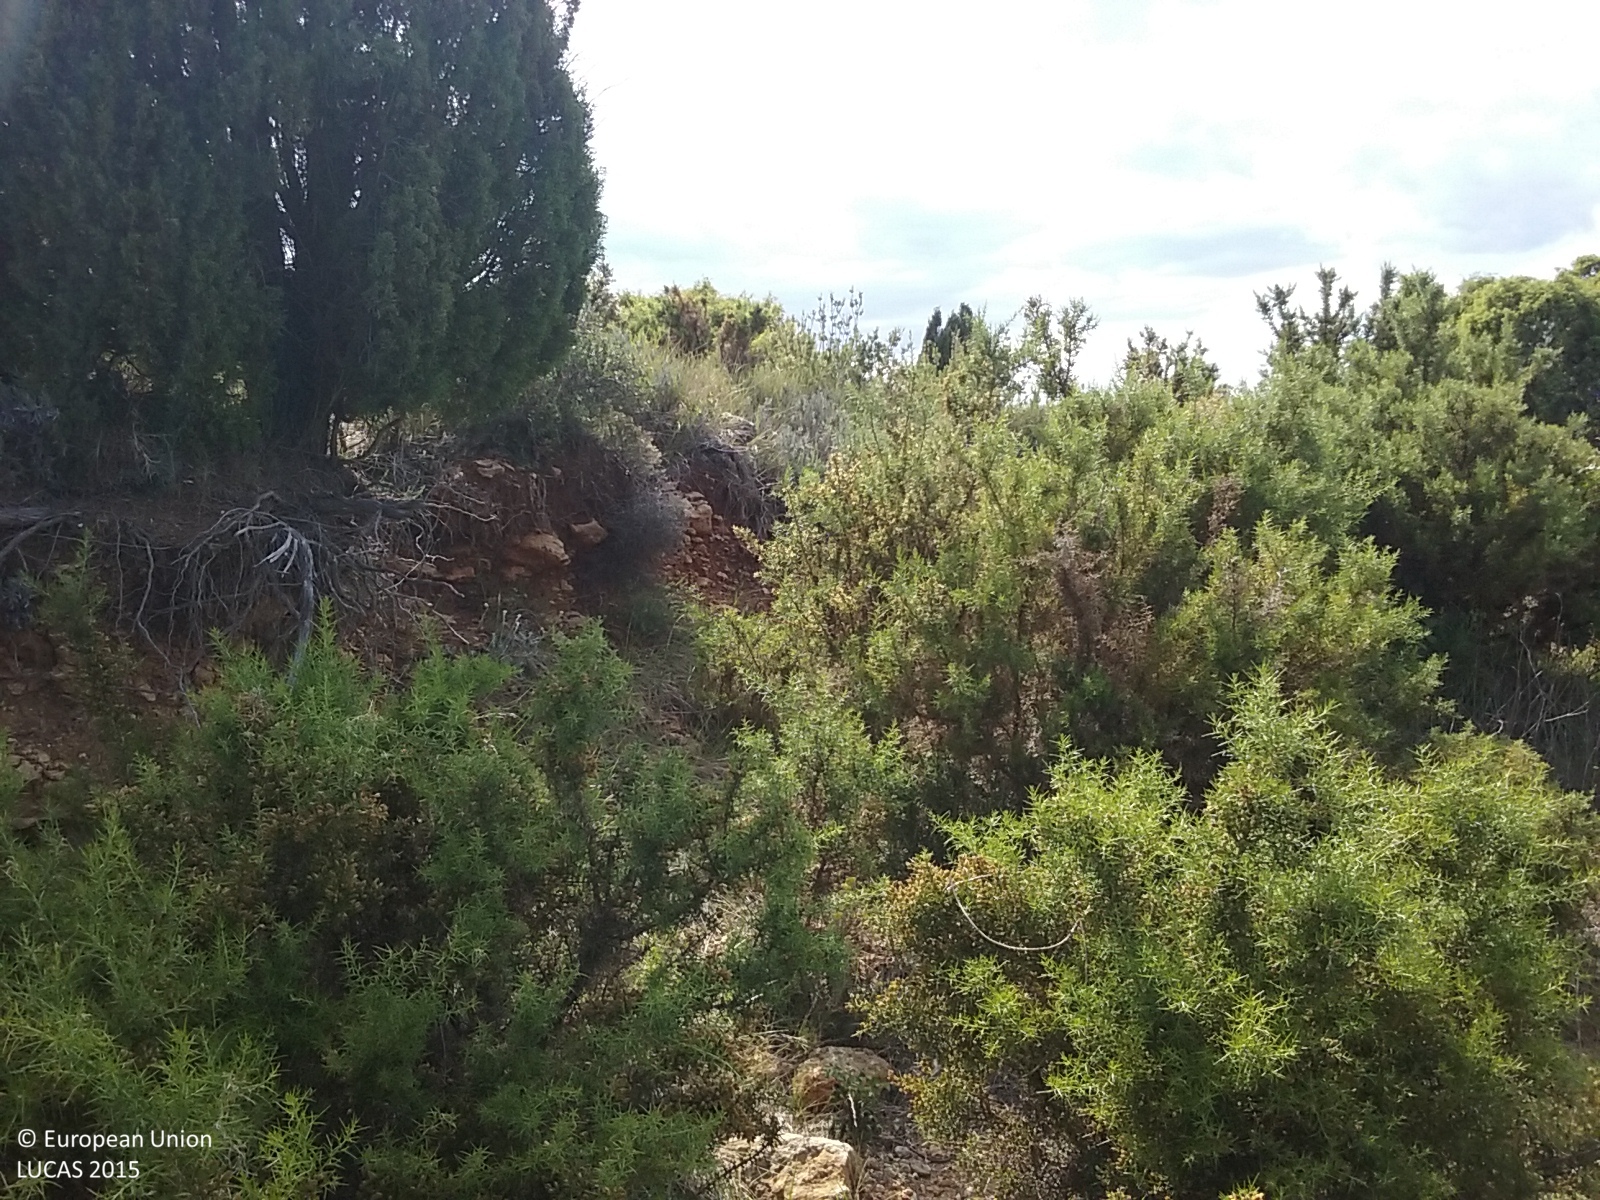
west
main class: Shrubland
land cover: Shrubland with sparse tree cover
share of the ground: > 75 %
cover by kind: shrubs 70 %, herbaceous plants 20 %, coniferous forest trees 5 %
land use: Semi-natural and natural areas not in use
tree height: < 5 m
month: May
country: ES
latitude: 40.3430
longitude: 0.0483
